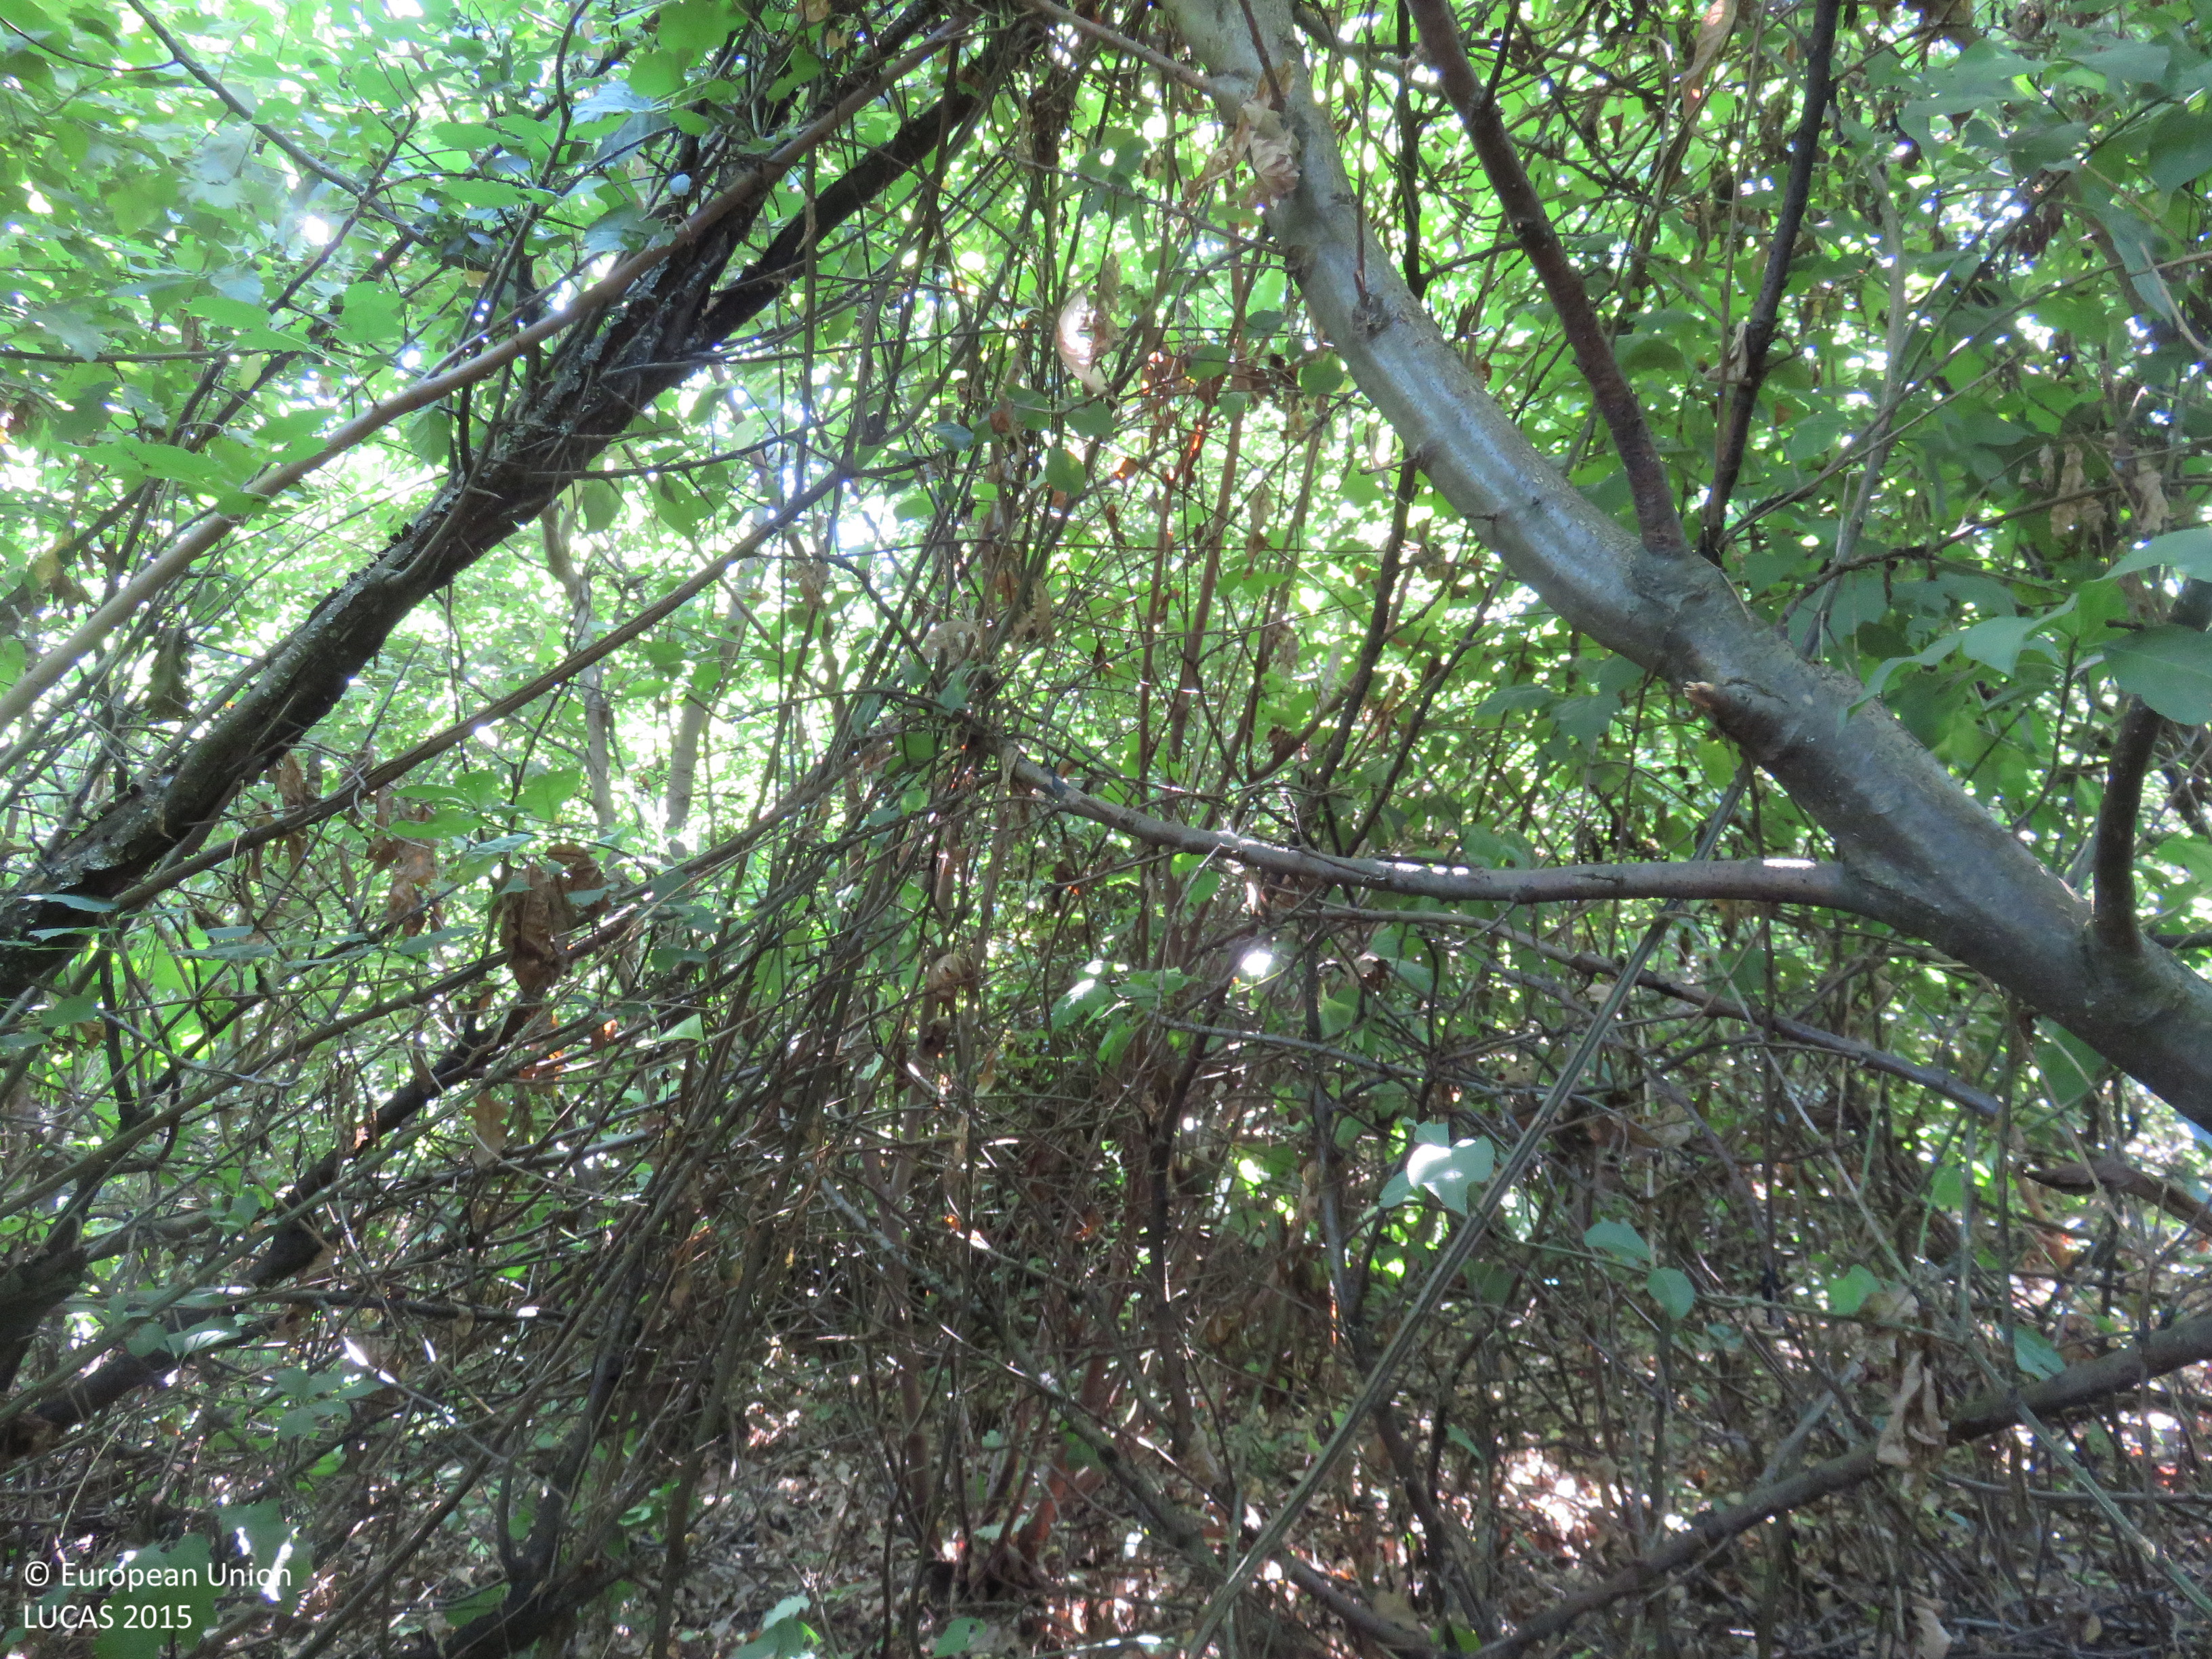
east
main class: Woodland
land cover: Broadleaved woodland
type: mesophytic deciduous forest
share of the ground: > 75 %
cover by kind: broadleaved forest trees 75 %, shrubs 25 %
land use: Semi-natural and natural areas not in use
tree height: < 5 m
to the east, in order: Broadleaved woodland; Grass margins; Common wheat
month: June
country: BG
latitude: 43.2376
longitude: 24.8551
